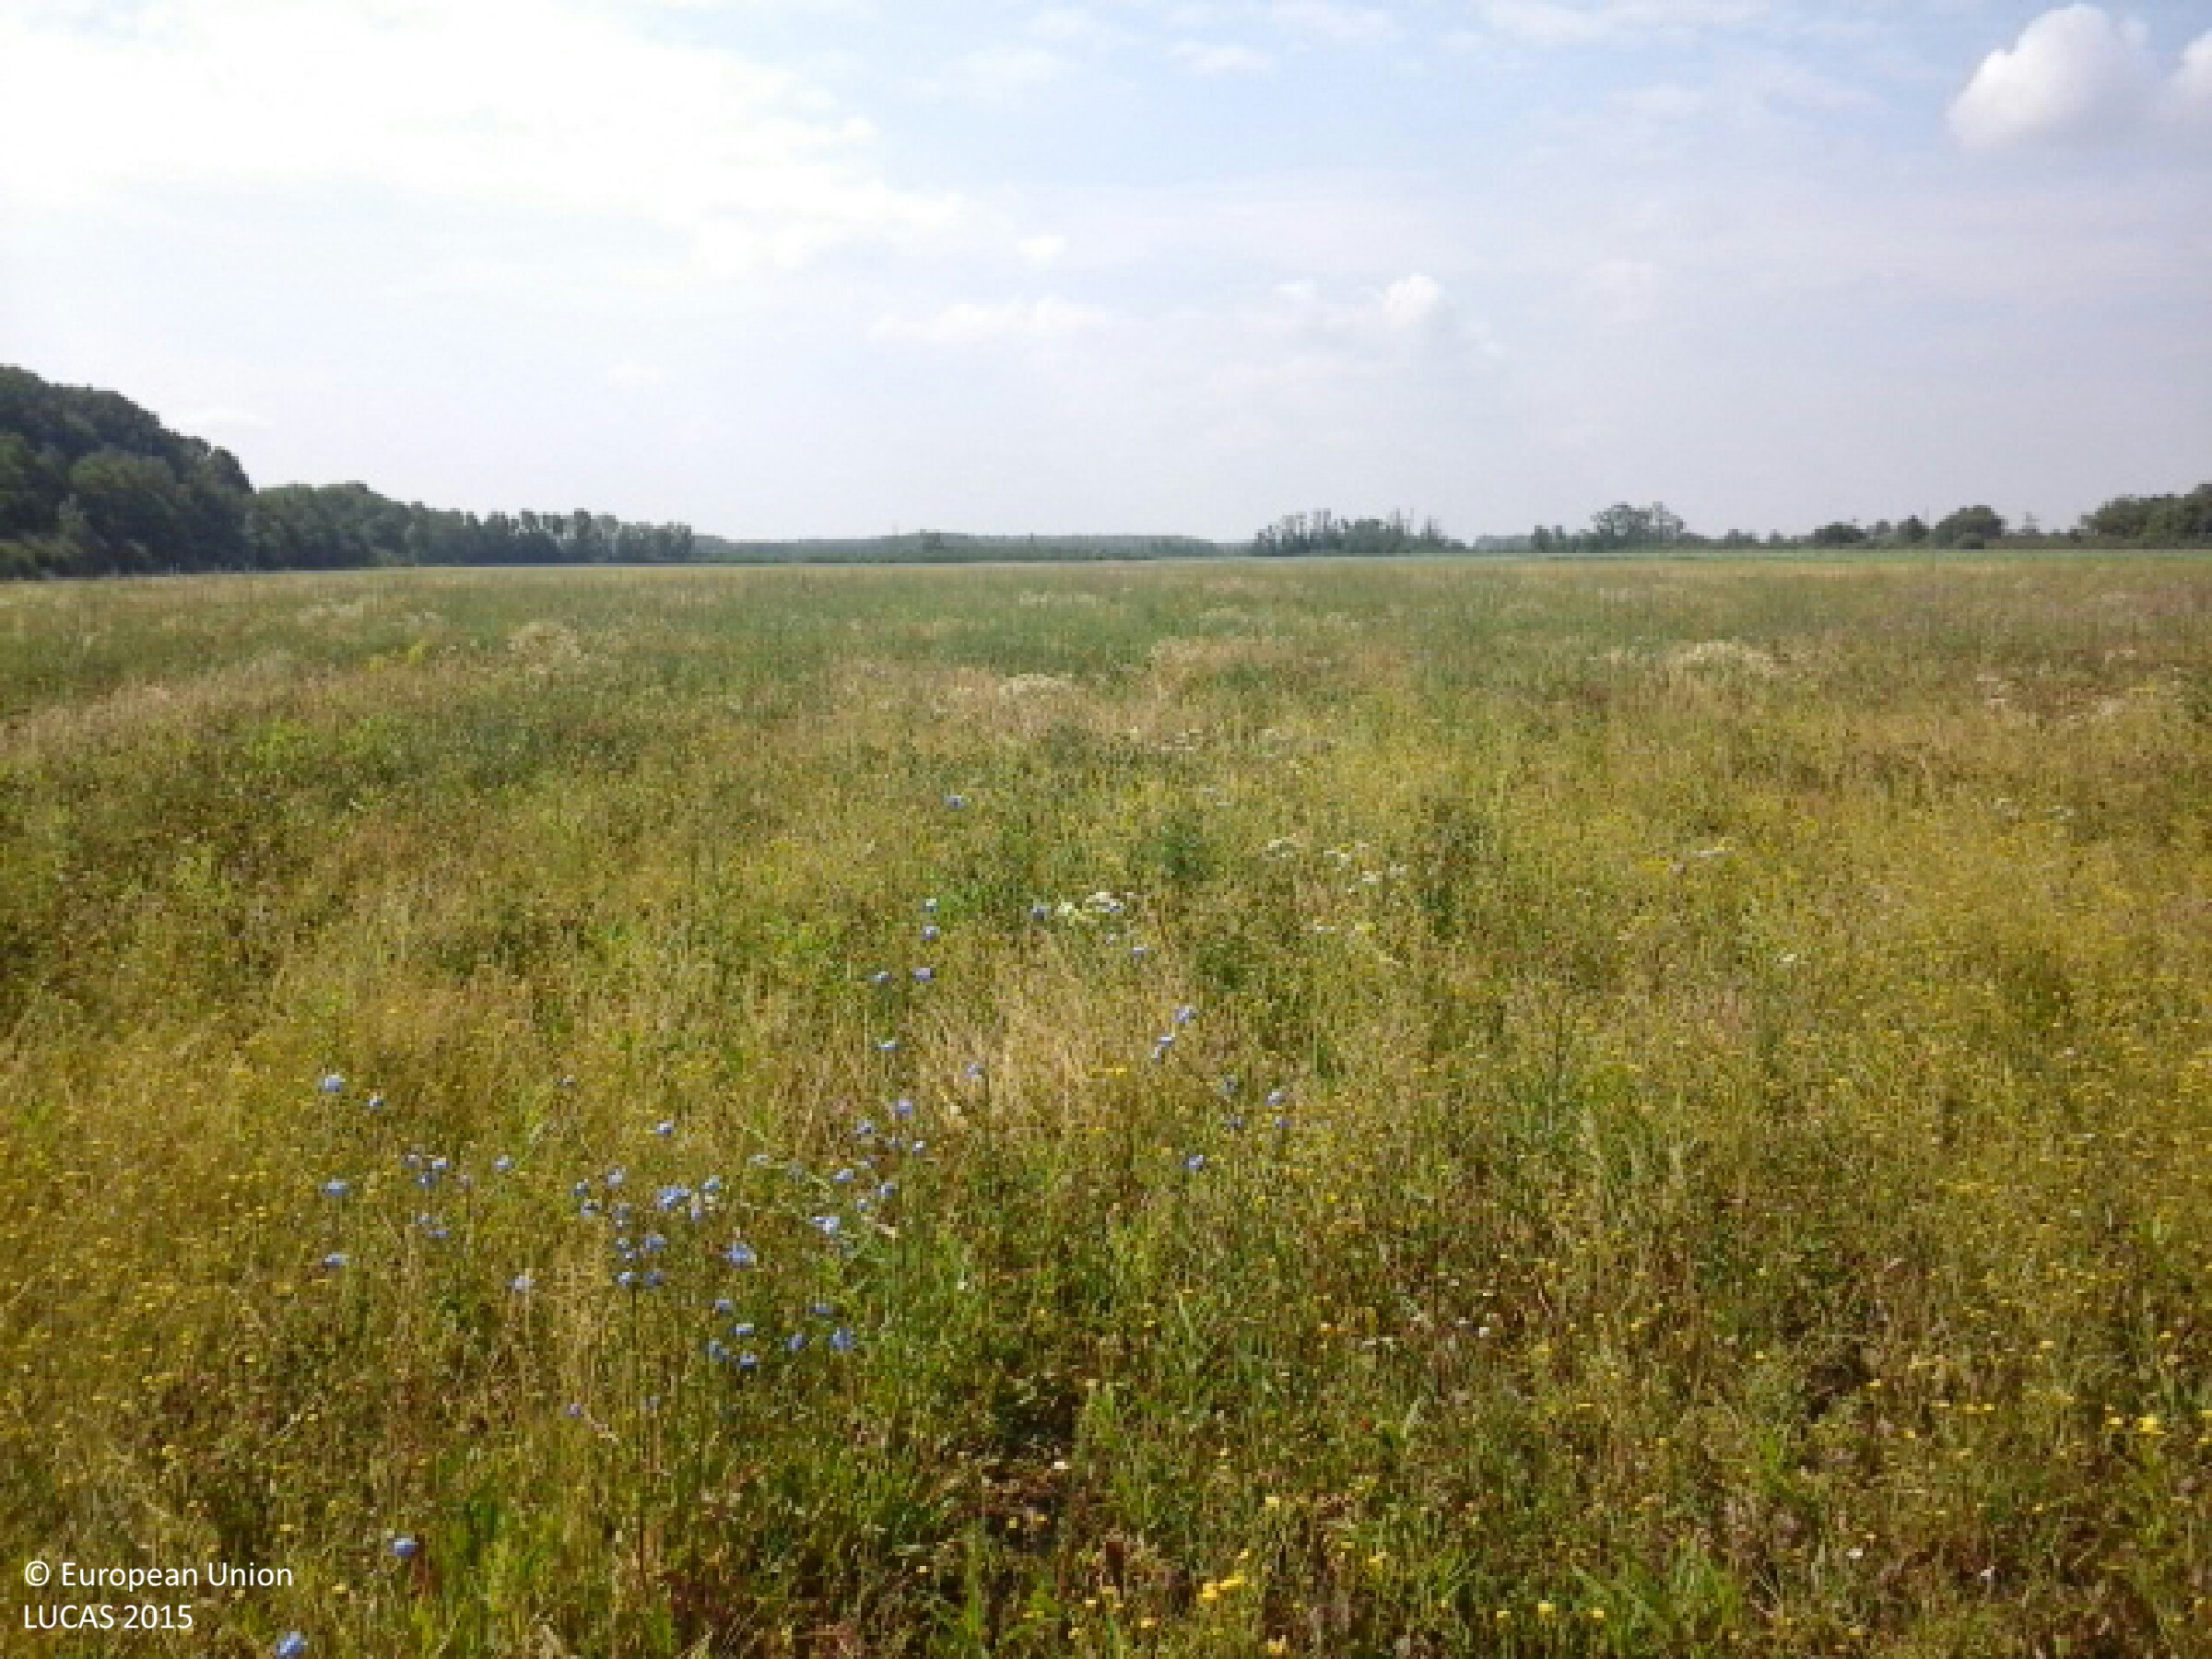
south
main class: Grassland
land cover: Grassland without tree/shrub cover
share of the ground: > 75 %
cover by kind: herbaceous plants 100 %
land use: Semi-natural and natural areas not in use
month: June
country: HU
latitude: 48.3179
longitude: 21.7690
